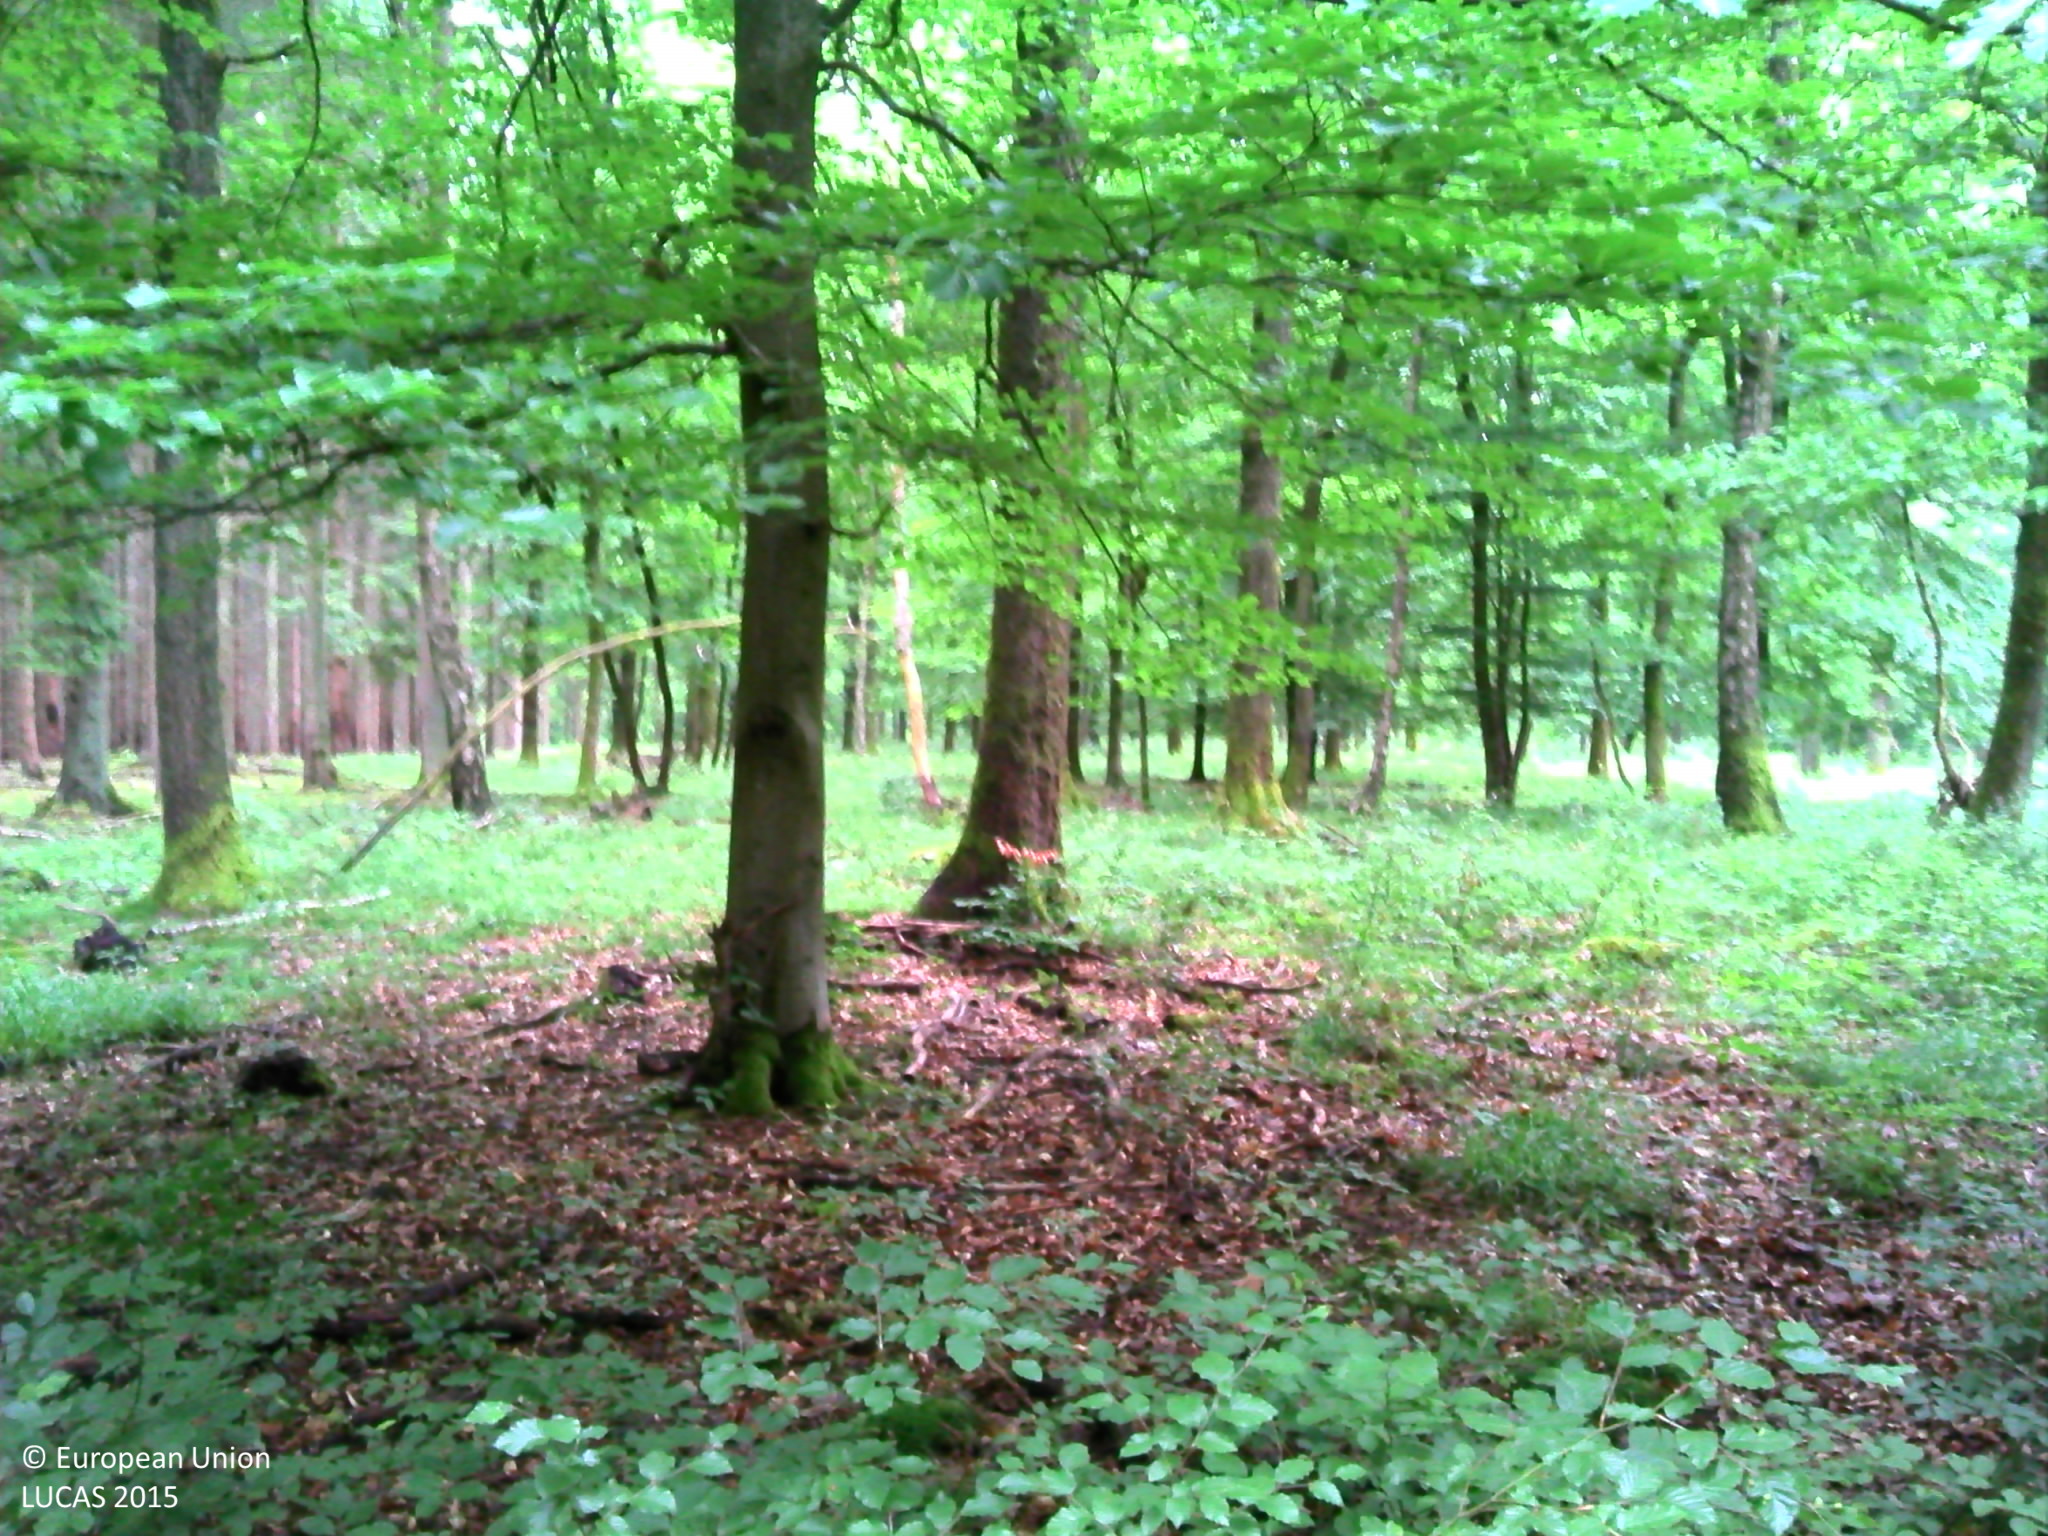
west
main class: Woodland
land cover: Broadleaved woodland
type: acidophilous oak and oak-birch forest
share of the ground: > 75 %
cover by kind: broadleaved forest trees 85 %, coniferous forest trees 5 %, herbaceous plants 5 %, lichens and mosses 5 %
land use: Forestry
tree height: > 5 m
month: June
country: BE
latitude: 50.3335
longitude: 5.6011
